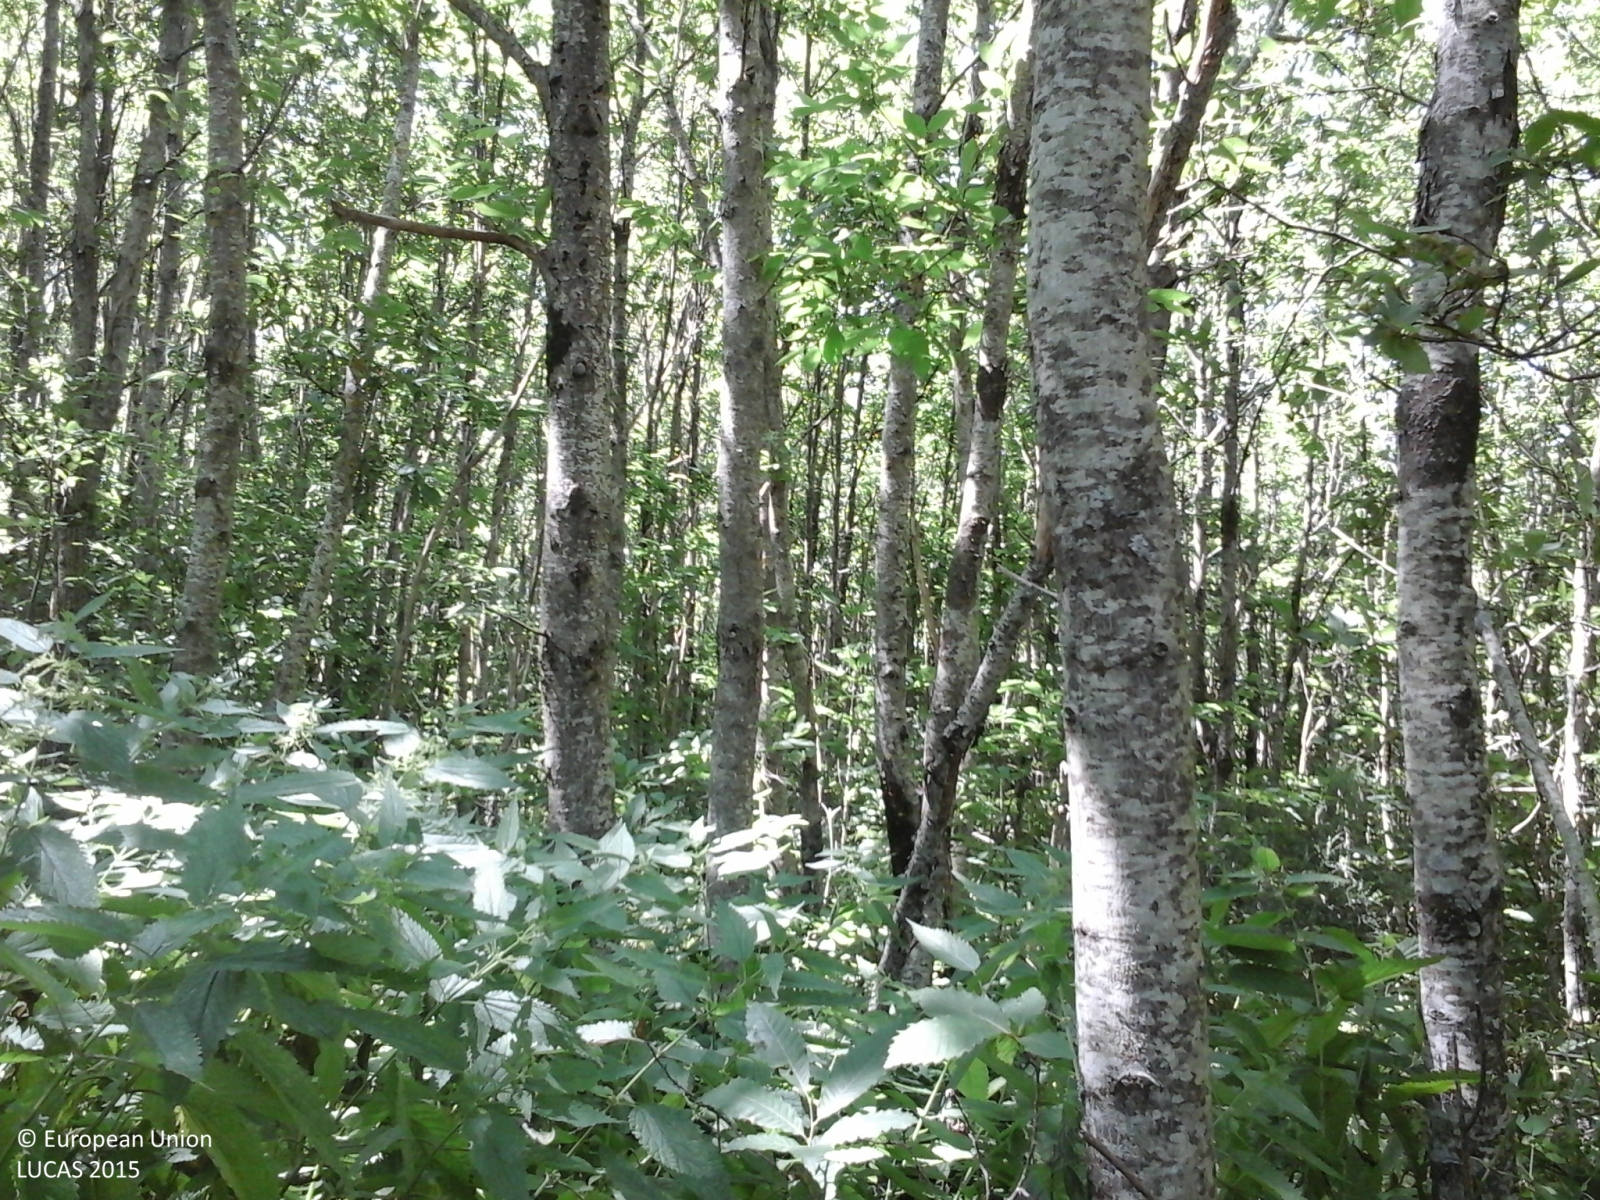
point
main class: Woodland
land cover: Broadleaved woodland
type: thermophilous deciduous forest
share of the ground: > 75 %
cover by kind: broadleaved forest trees 80 %, shrubs 20 %
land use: Forestry
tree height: > 5 m
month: July
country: IT
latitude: 40.8799
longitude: 14.6923
